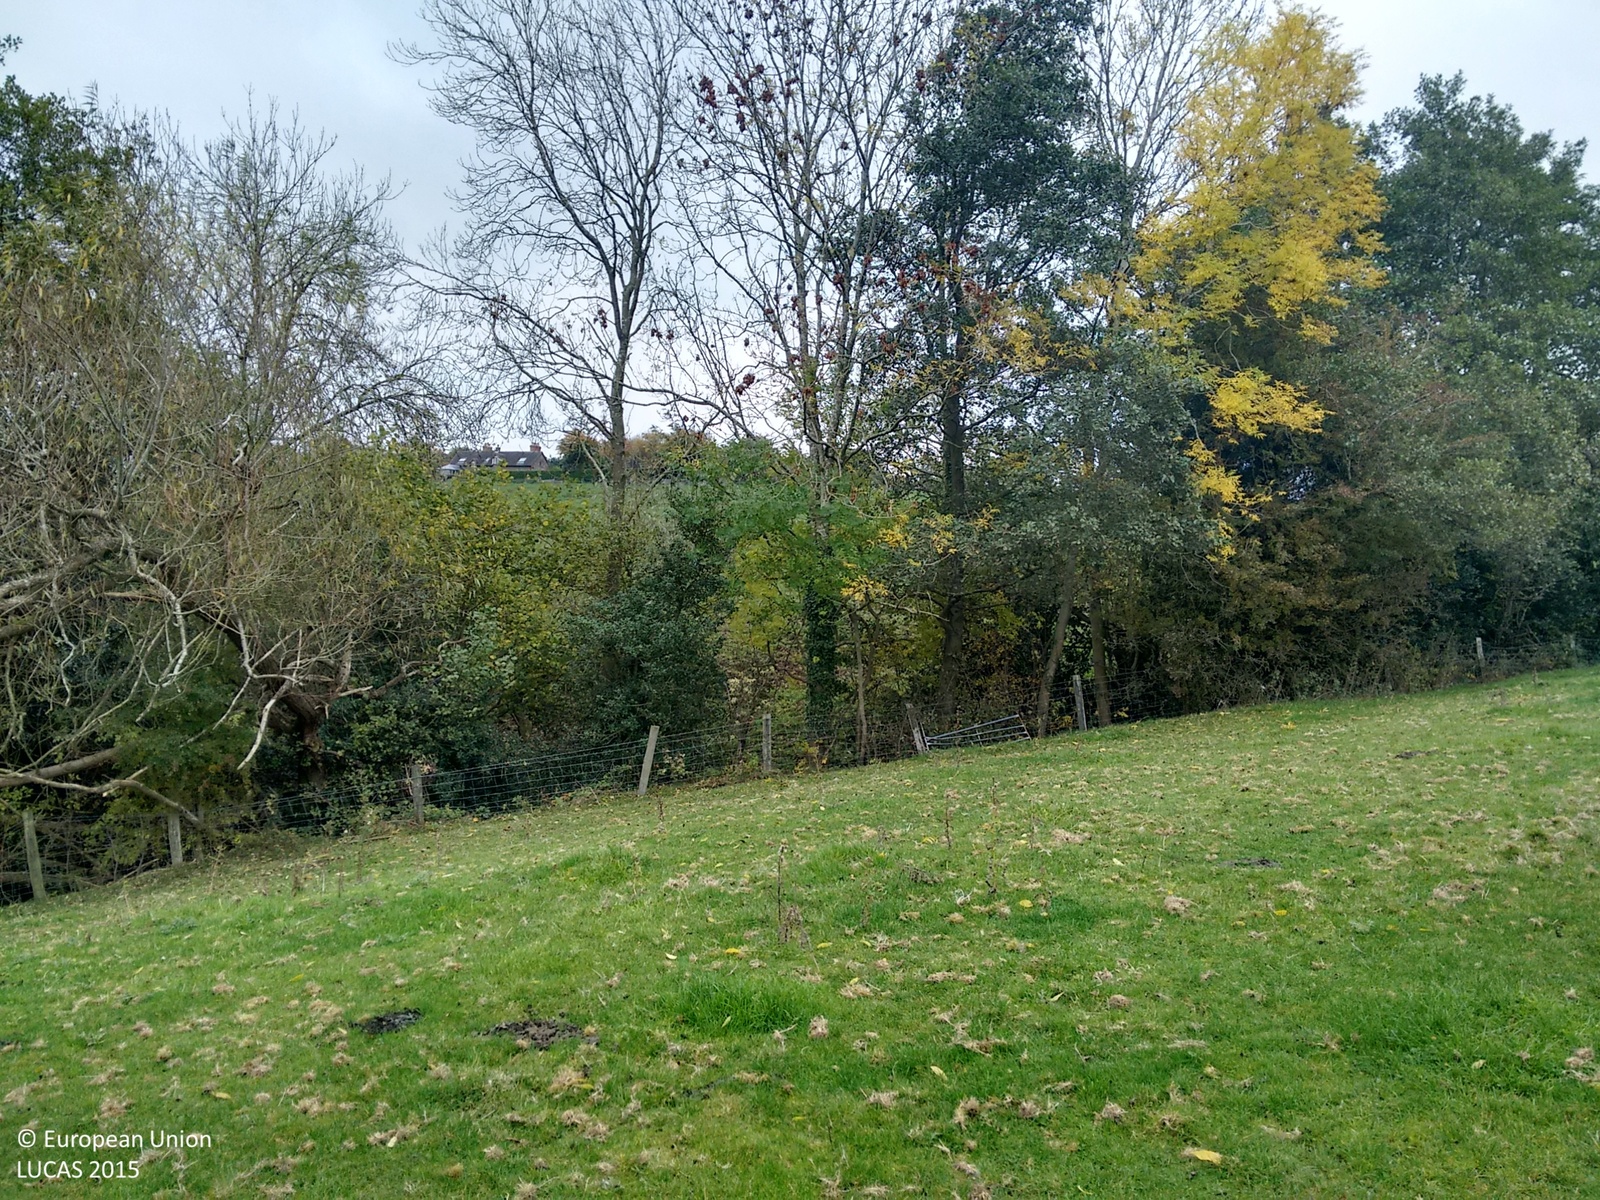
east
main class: Grassland
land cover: Grassland without tree/shrub cover
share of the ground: > 75 %
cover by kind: herbaceous plants 100 %
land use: Agriculture (excluding fallow land and kitchen gardens)
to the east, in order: Grassland without tree/shrub cover; Fences; Abandoned hedges; Ditches and canals; Grassland without tree/shrub cover; Fences; Managed hedges; Grassland without tree/shrub cover; Artificial constructions in urban areas; Managed hedges; Grassland without tree/shrub cover
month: October
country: GB
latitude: 52.4959
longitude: -2.8426
